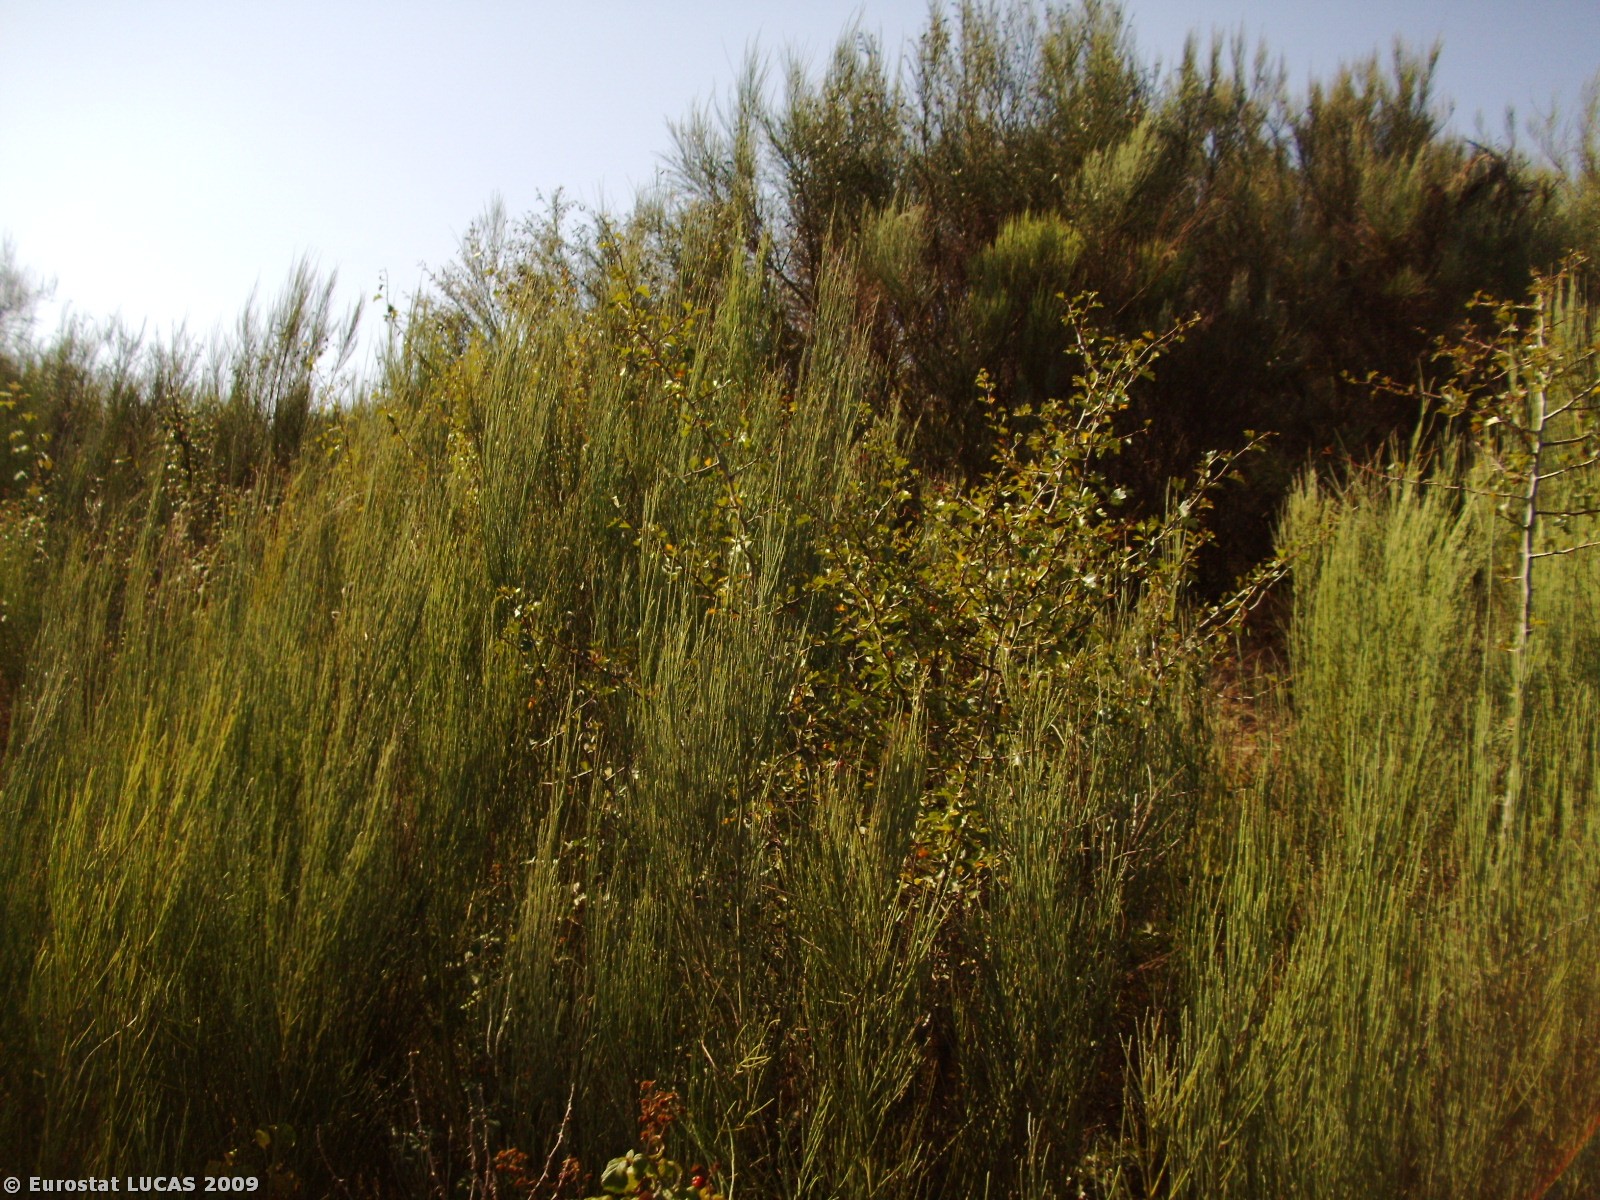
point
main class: Shrubland
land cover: Shrubland without tree cover
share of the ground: > 75 %
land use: Fallow land
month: August
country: PT
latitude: 40.1863
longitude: -7.6449
